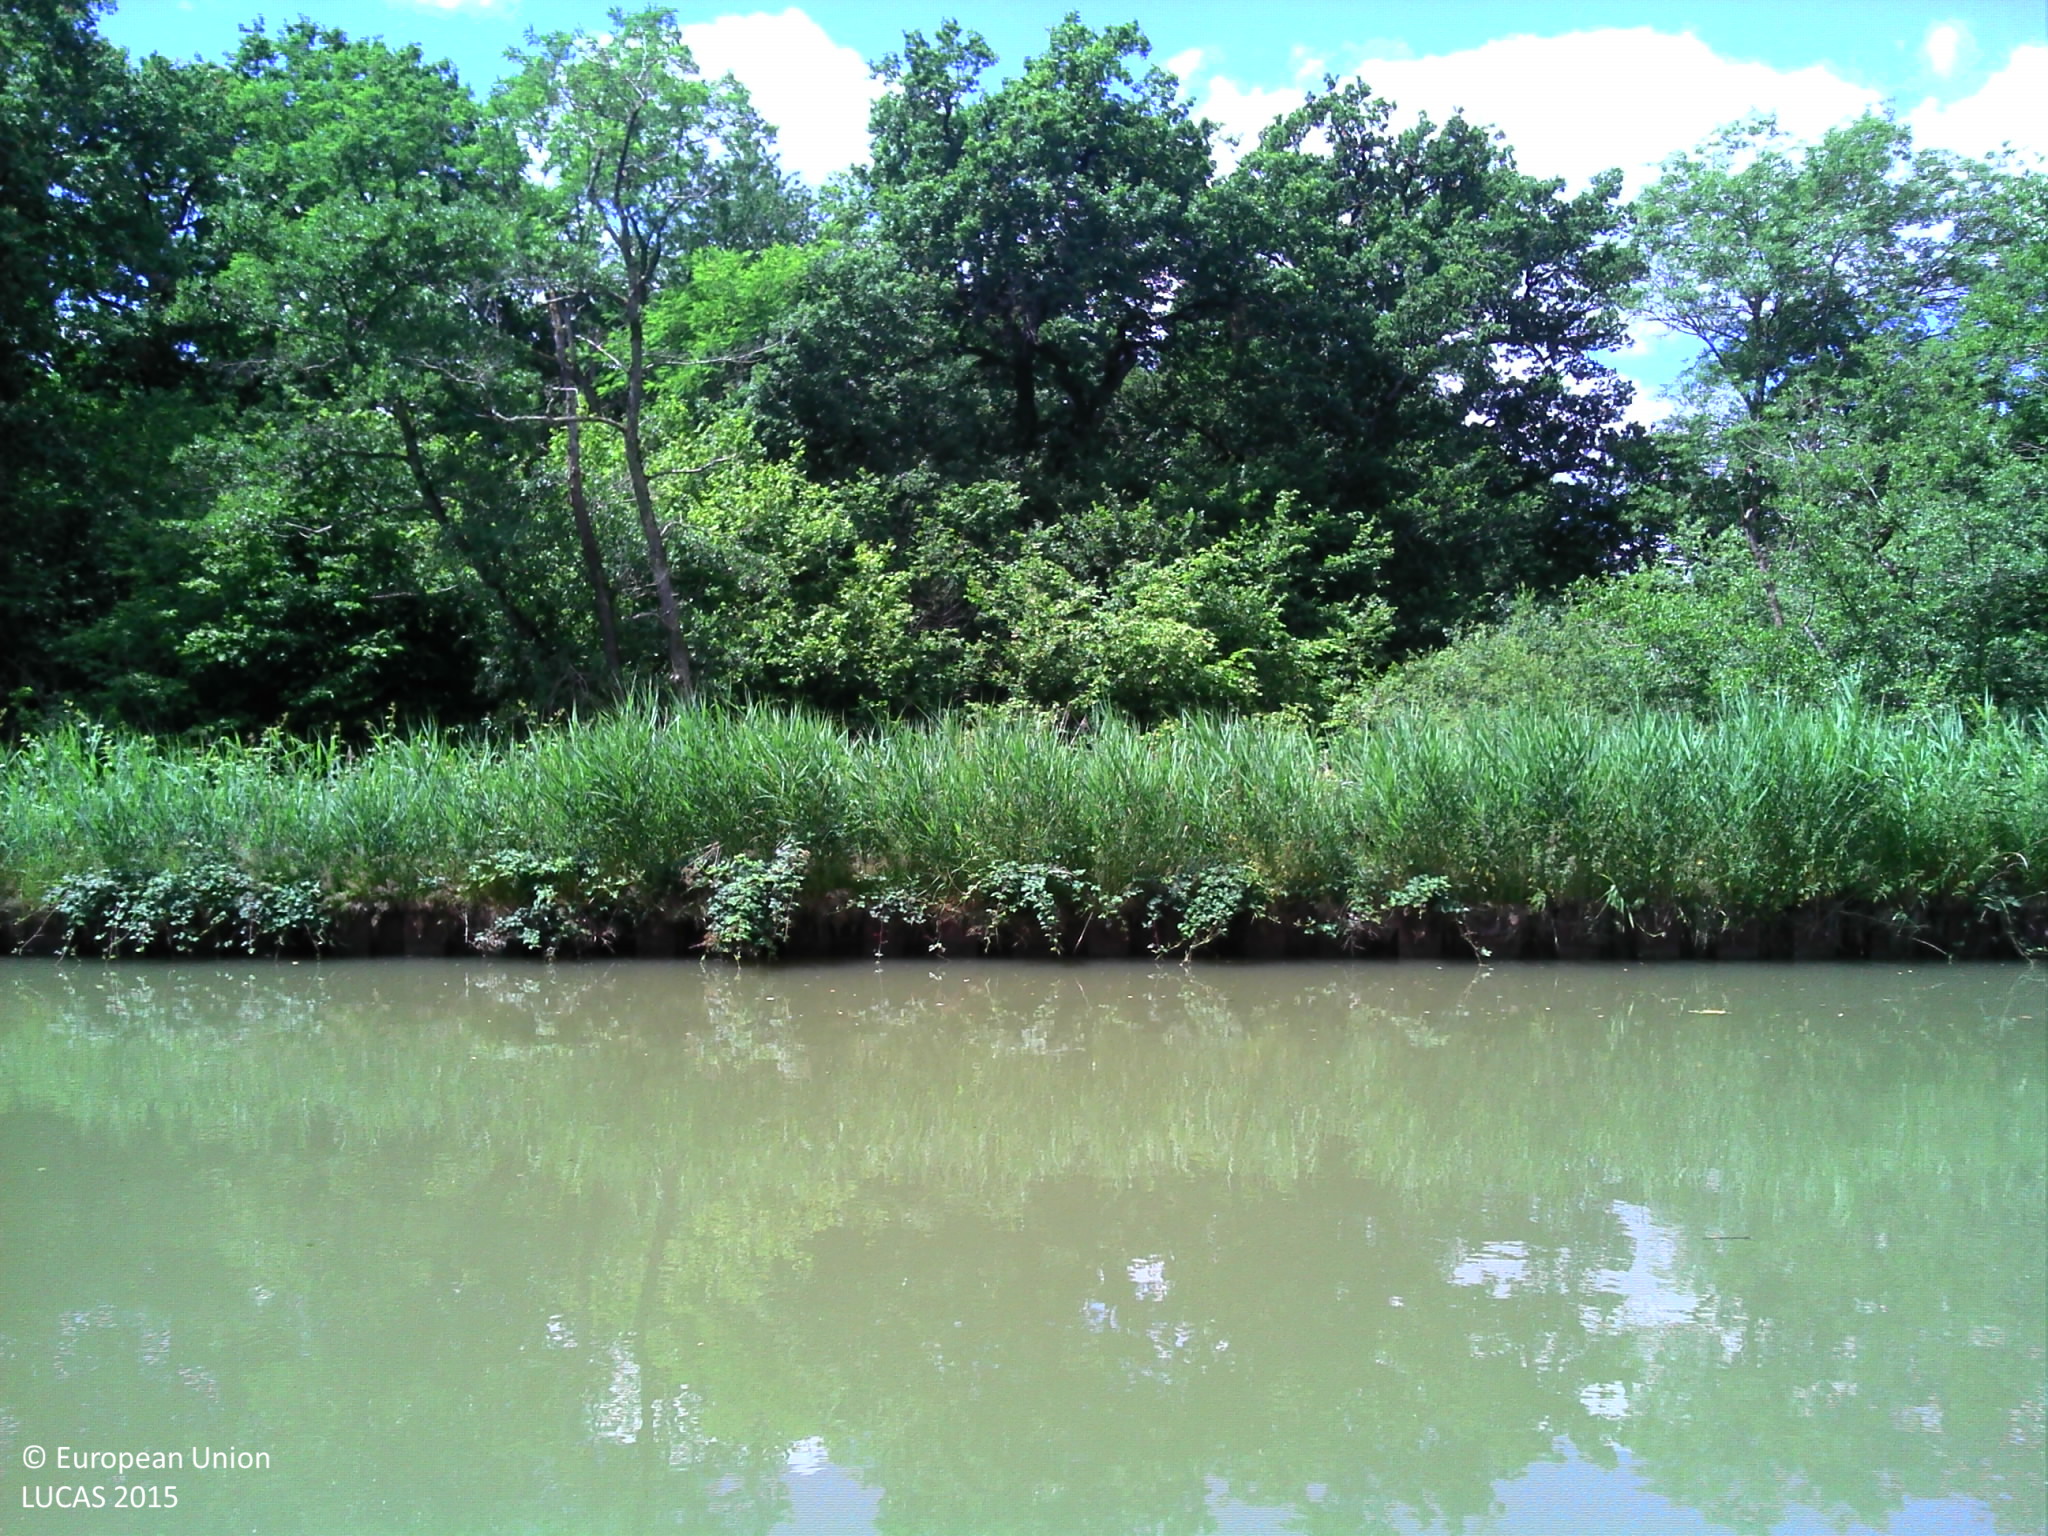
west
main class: Woodland
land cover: Broadleaved woodland
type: acidophilous oak and oak-birch forest
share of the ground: > 75 %
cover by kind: broadleaved forest trees 90 %, shrubs 5 %, herbaceous plants 5 %
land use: Semi-natural and natural areas not in use
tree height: > 5 m
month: June
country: FR
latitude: 46.6673
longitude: 3.6335
